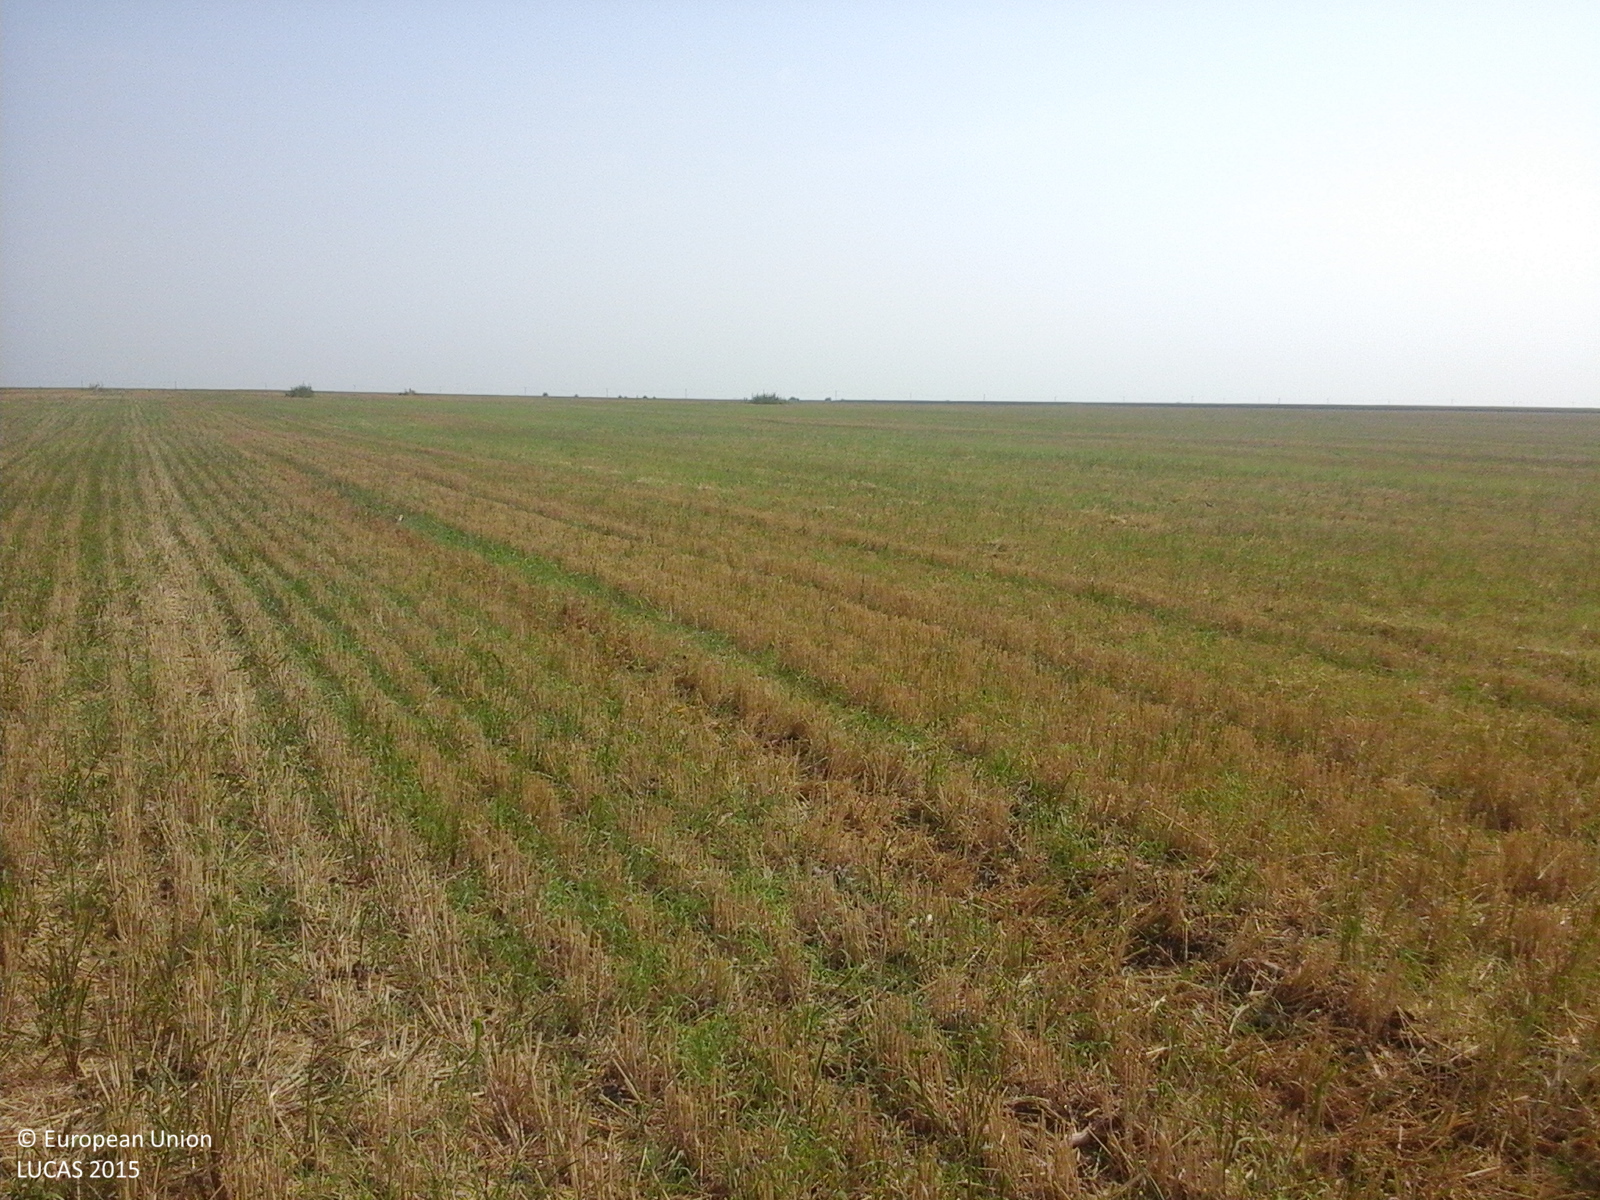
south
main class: Cropland
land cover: Common wheat
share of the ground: > 75 %
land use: Agriculture (excluding fallow land and kitchen gardens)
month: July
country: RO
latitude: 45.6860
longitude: 27.6081
